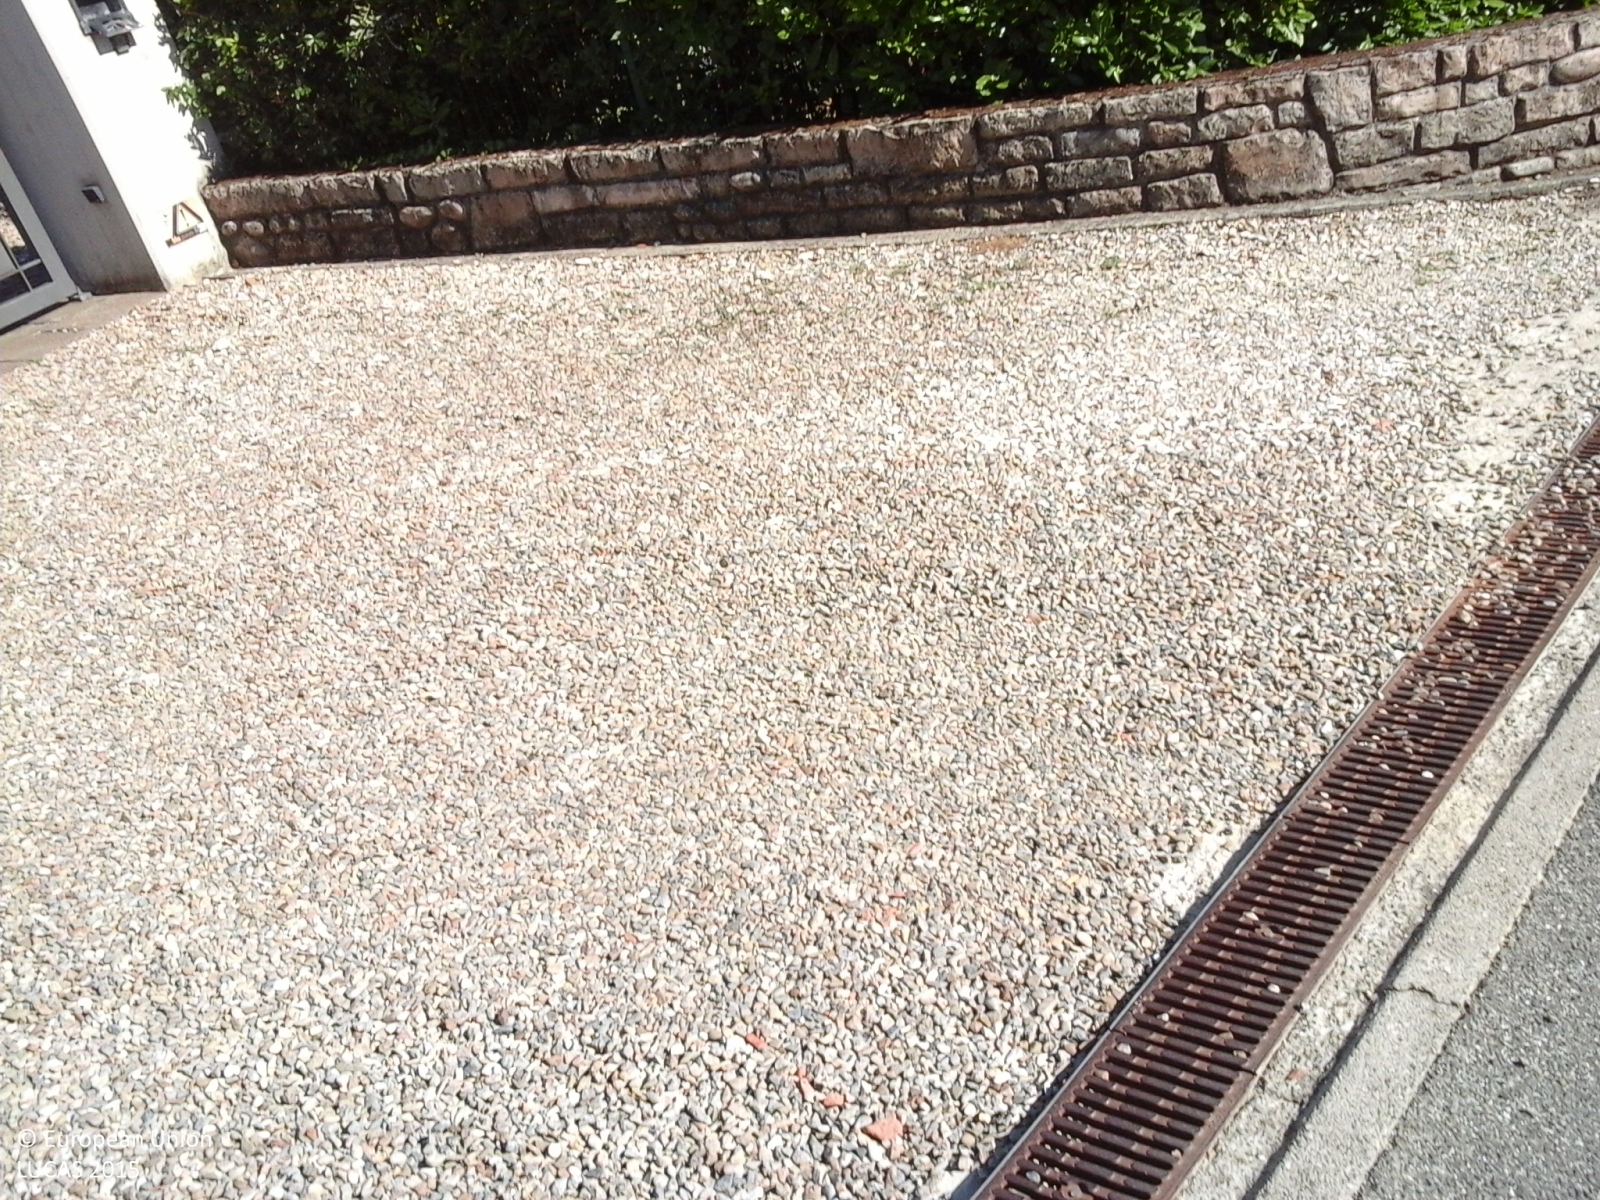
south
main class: Cropland
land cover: Olive groves
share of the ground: > 75 %
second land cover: Grassland without tree/shrub cover
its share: > 75 %
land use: Agriculture (excluding fallow land and kitchen gardens)
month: June
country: IT
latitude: 43.7496
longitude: 11.0776
